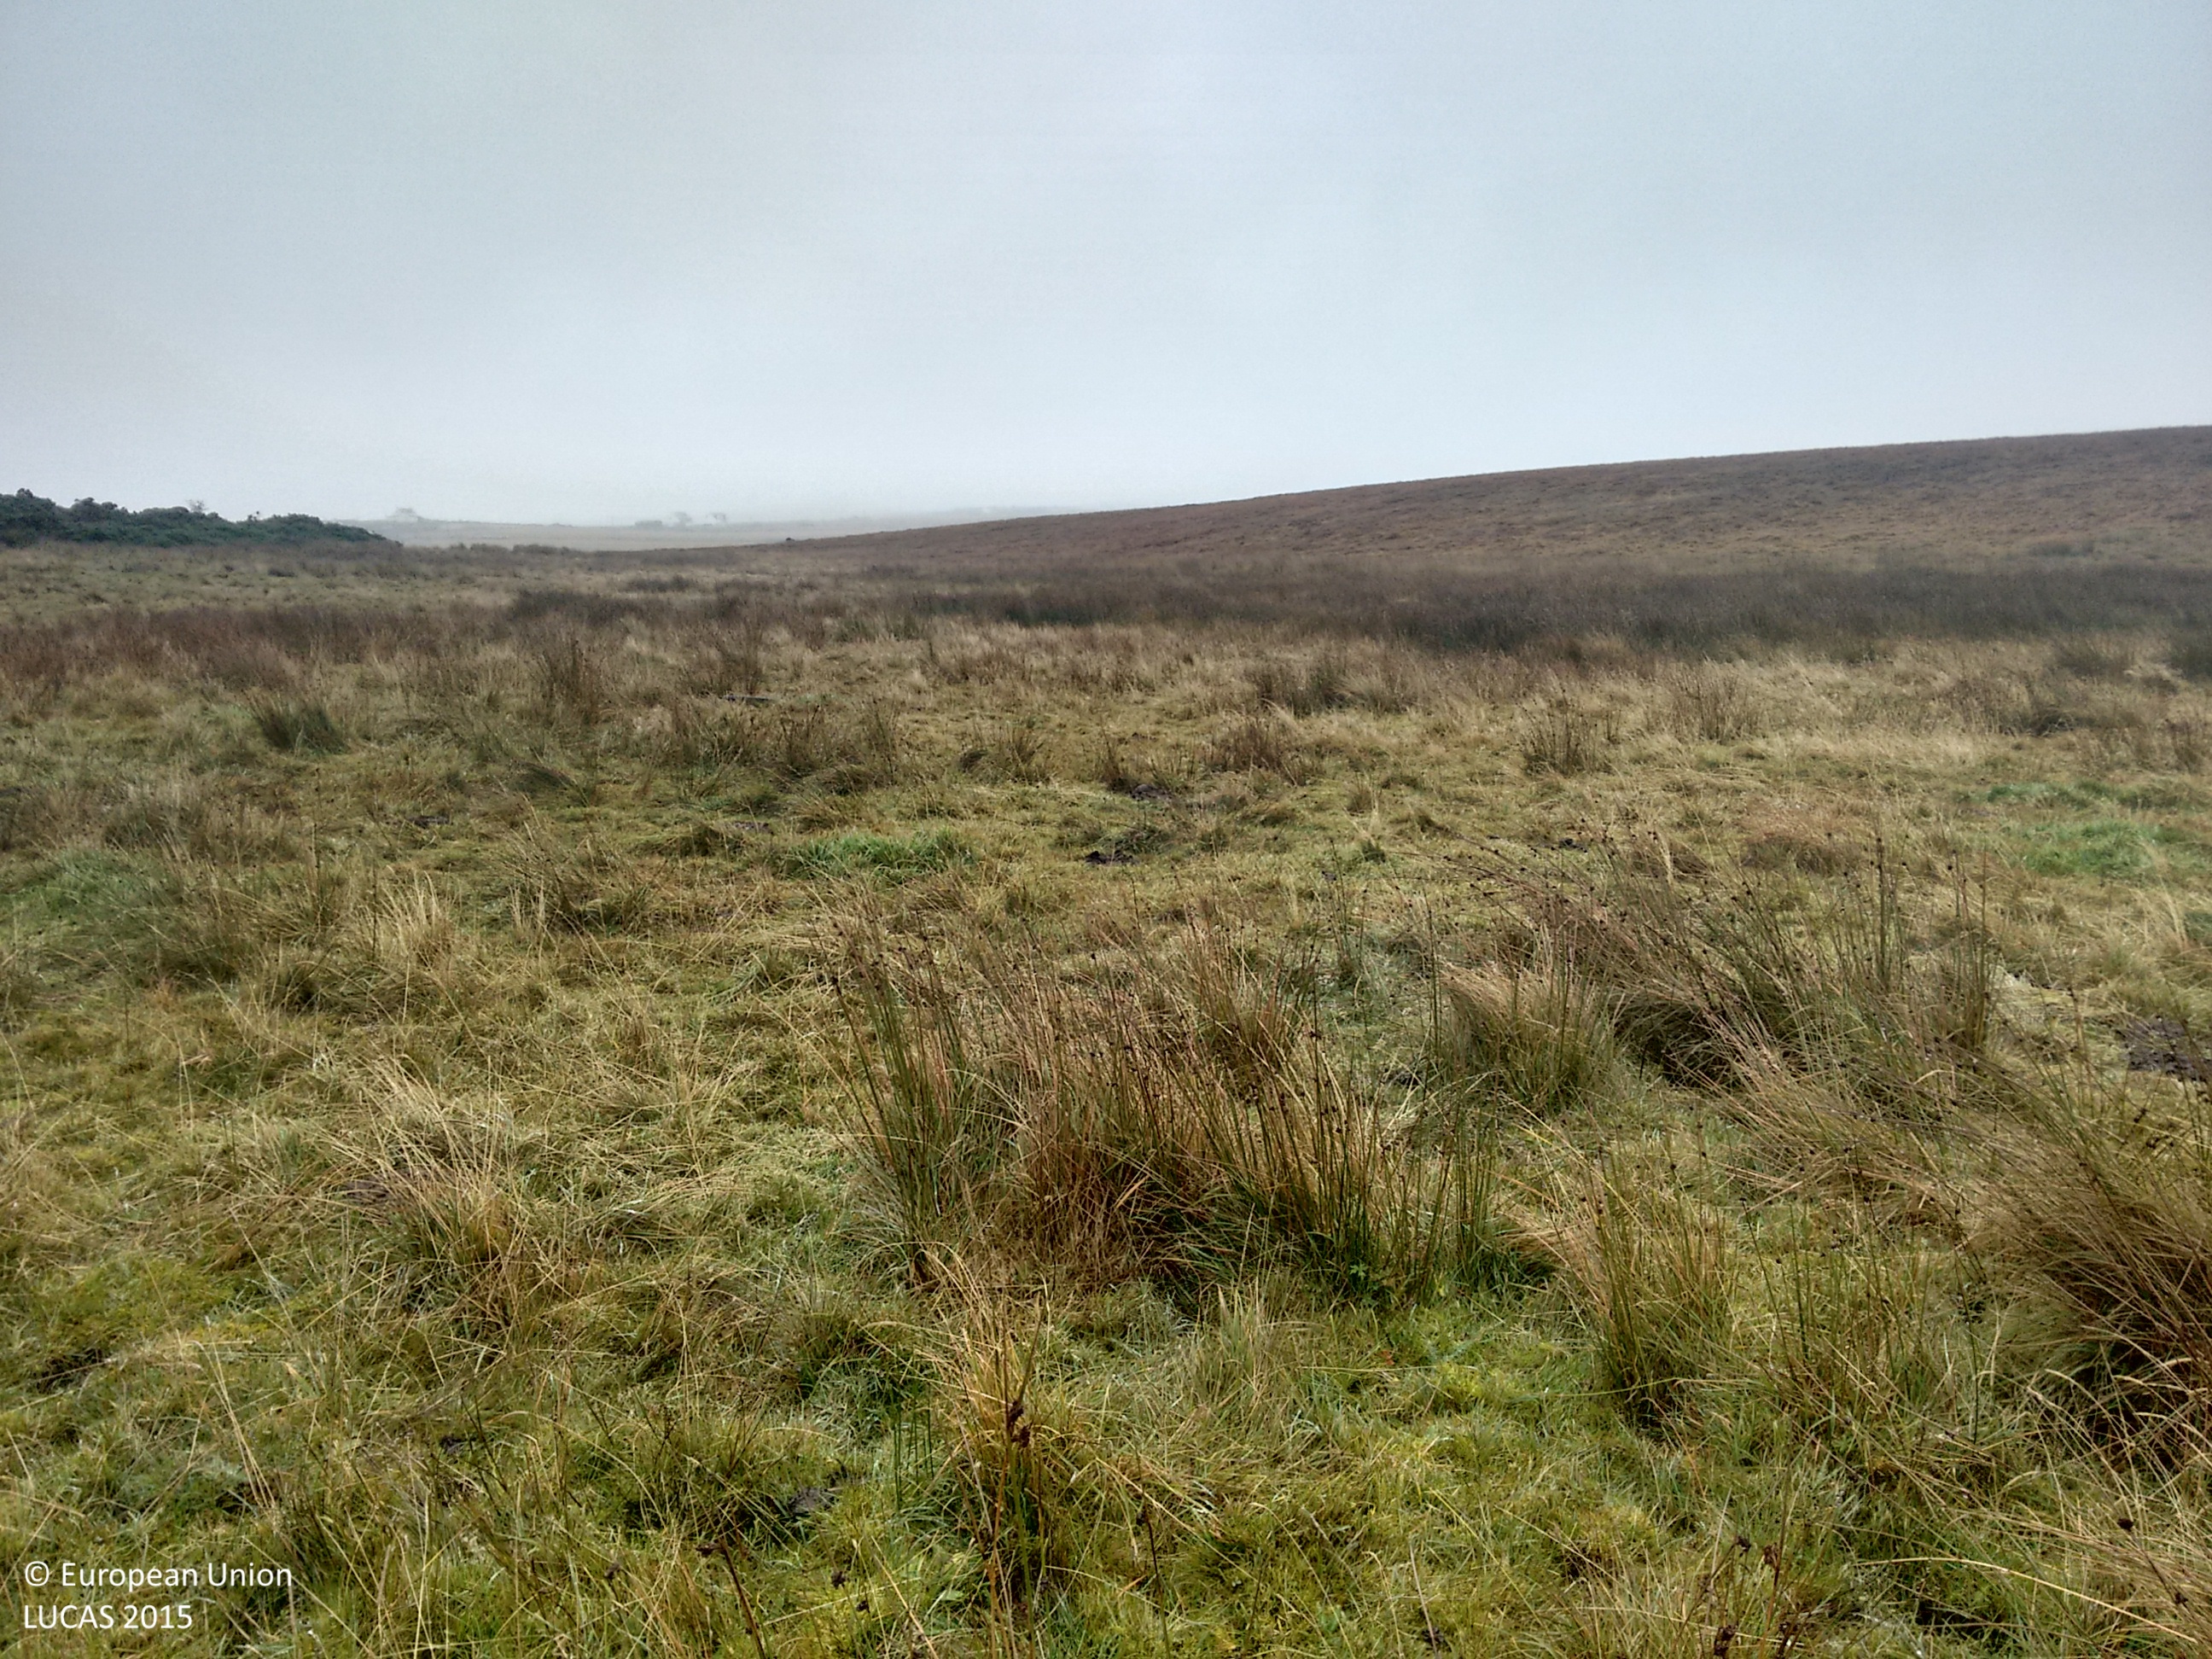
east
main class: Grassland
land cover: Grassland without tree/shrub cover
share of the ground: > 75 %
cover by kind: herbaceous plants 80 %, lichens and mosses 20 %
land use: Agriculture (excluding fallow land and kitchen gardens)
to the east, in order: Grassland without tree/shrub cover; Peatbogs
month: October
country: GB
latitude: 55.7441
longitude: -6.2814
